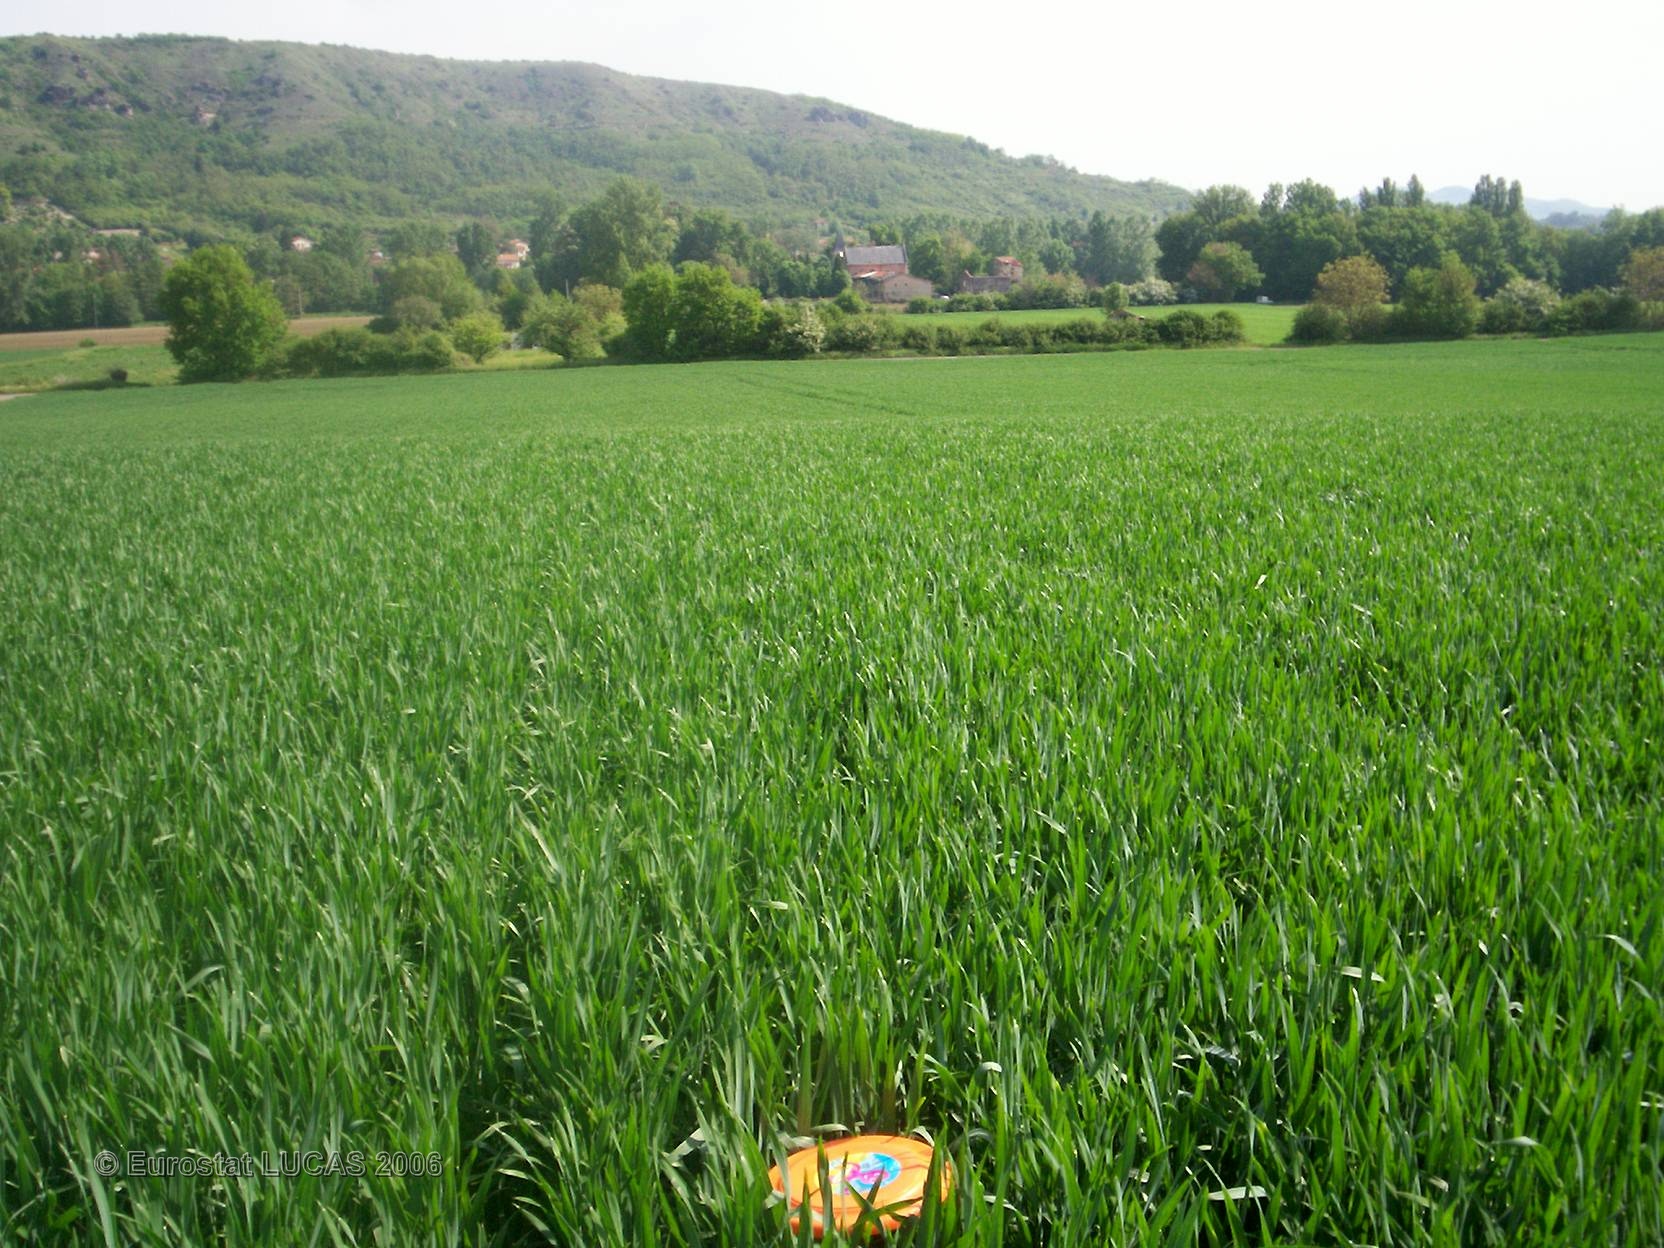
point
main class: Cropland
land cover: Common wheat
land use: Agriculture (excluding fallow land and kitchen gardens)
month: May
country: FR
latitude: 45.5382
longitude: 3.2007
